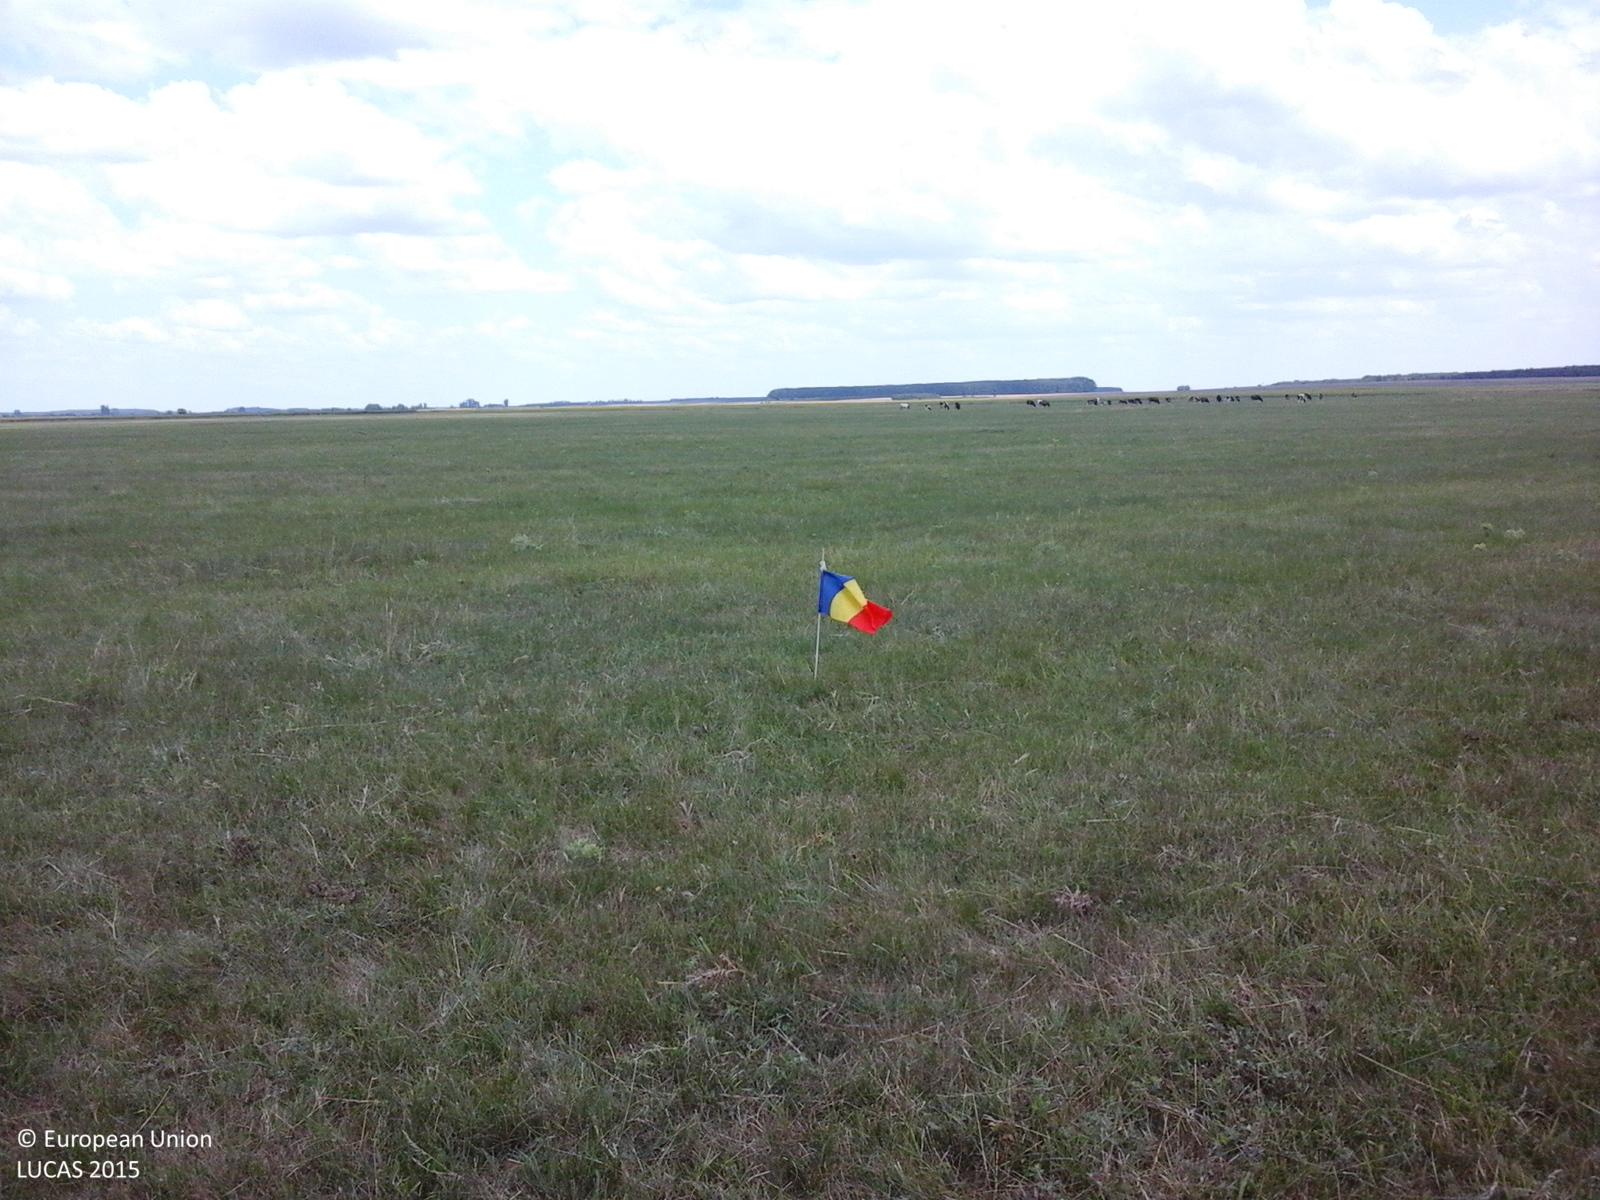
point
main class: Grassland
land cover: Grassland without tree/shrub cover
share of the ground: > 75 %
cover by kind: herbaceous plants 100 %
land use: Agriculture (excluding fallow land and kitchen gardens)
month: July
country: RO
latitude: 44.2118
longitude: 24.8307
